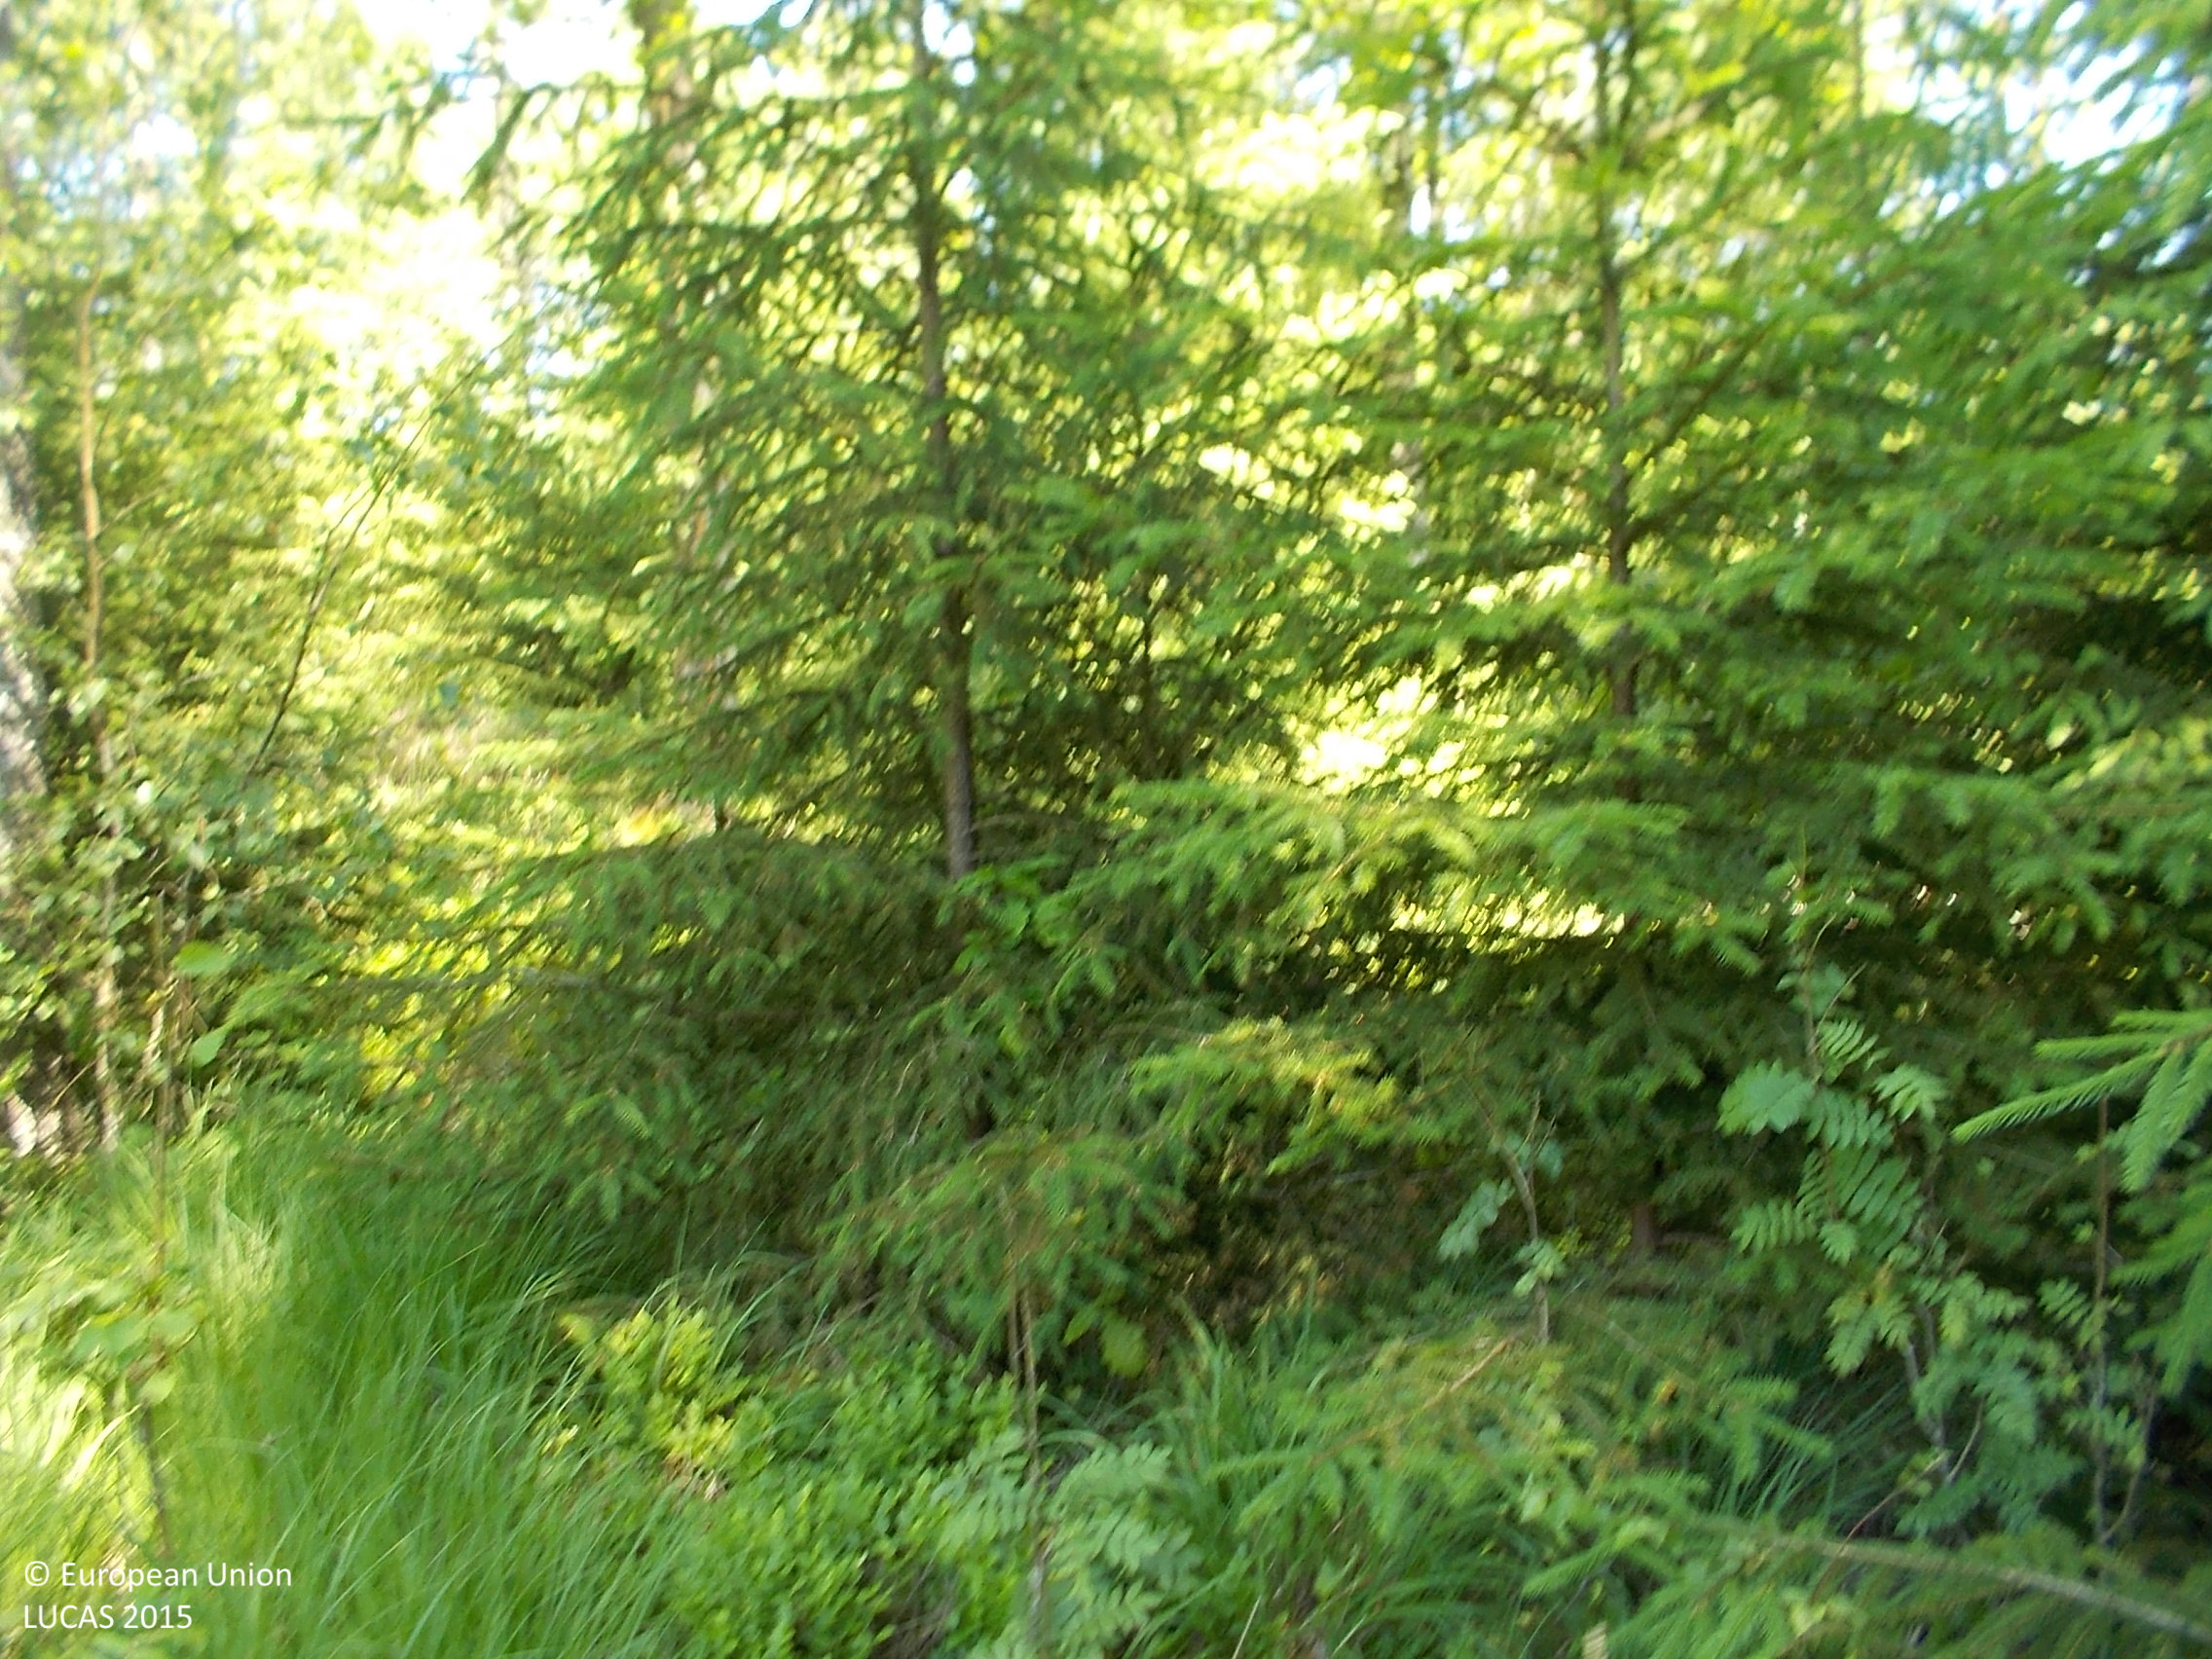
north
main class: Woodland
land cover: Spruce dominated mixed woodland
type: hemiboreal forest and nemoral coniferous forest and mixed broadleaved-coniferous forest
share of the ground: 50 - 75 %
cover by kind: broadleaved forest trees 45 %, shrubs 20 %, herbaceous plants 20 %, coniferous forest trees 15 %
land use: Forestry
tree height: > 5 m
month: July
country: SE
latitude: 57.1814
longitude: 12.8583
